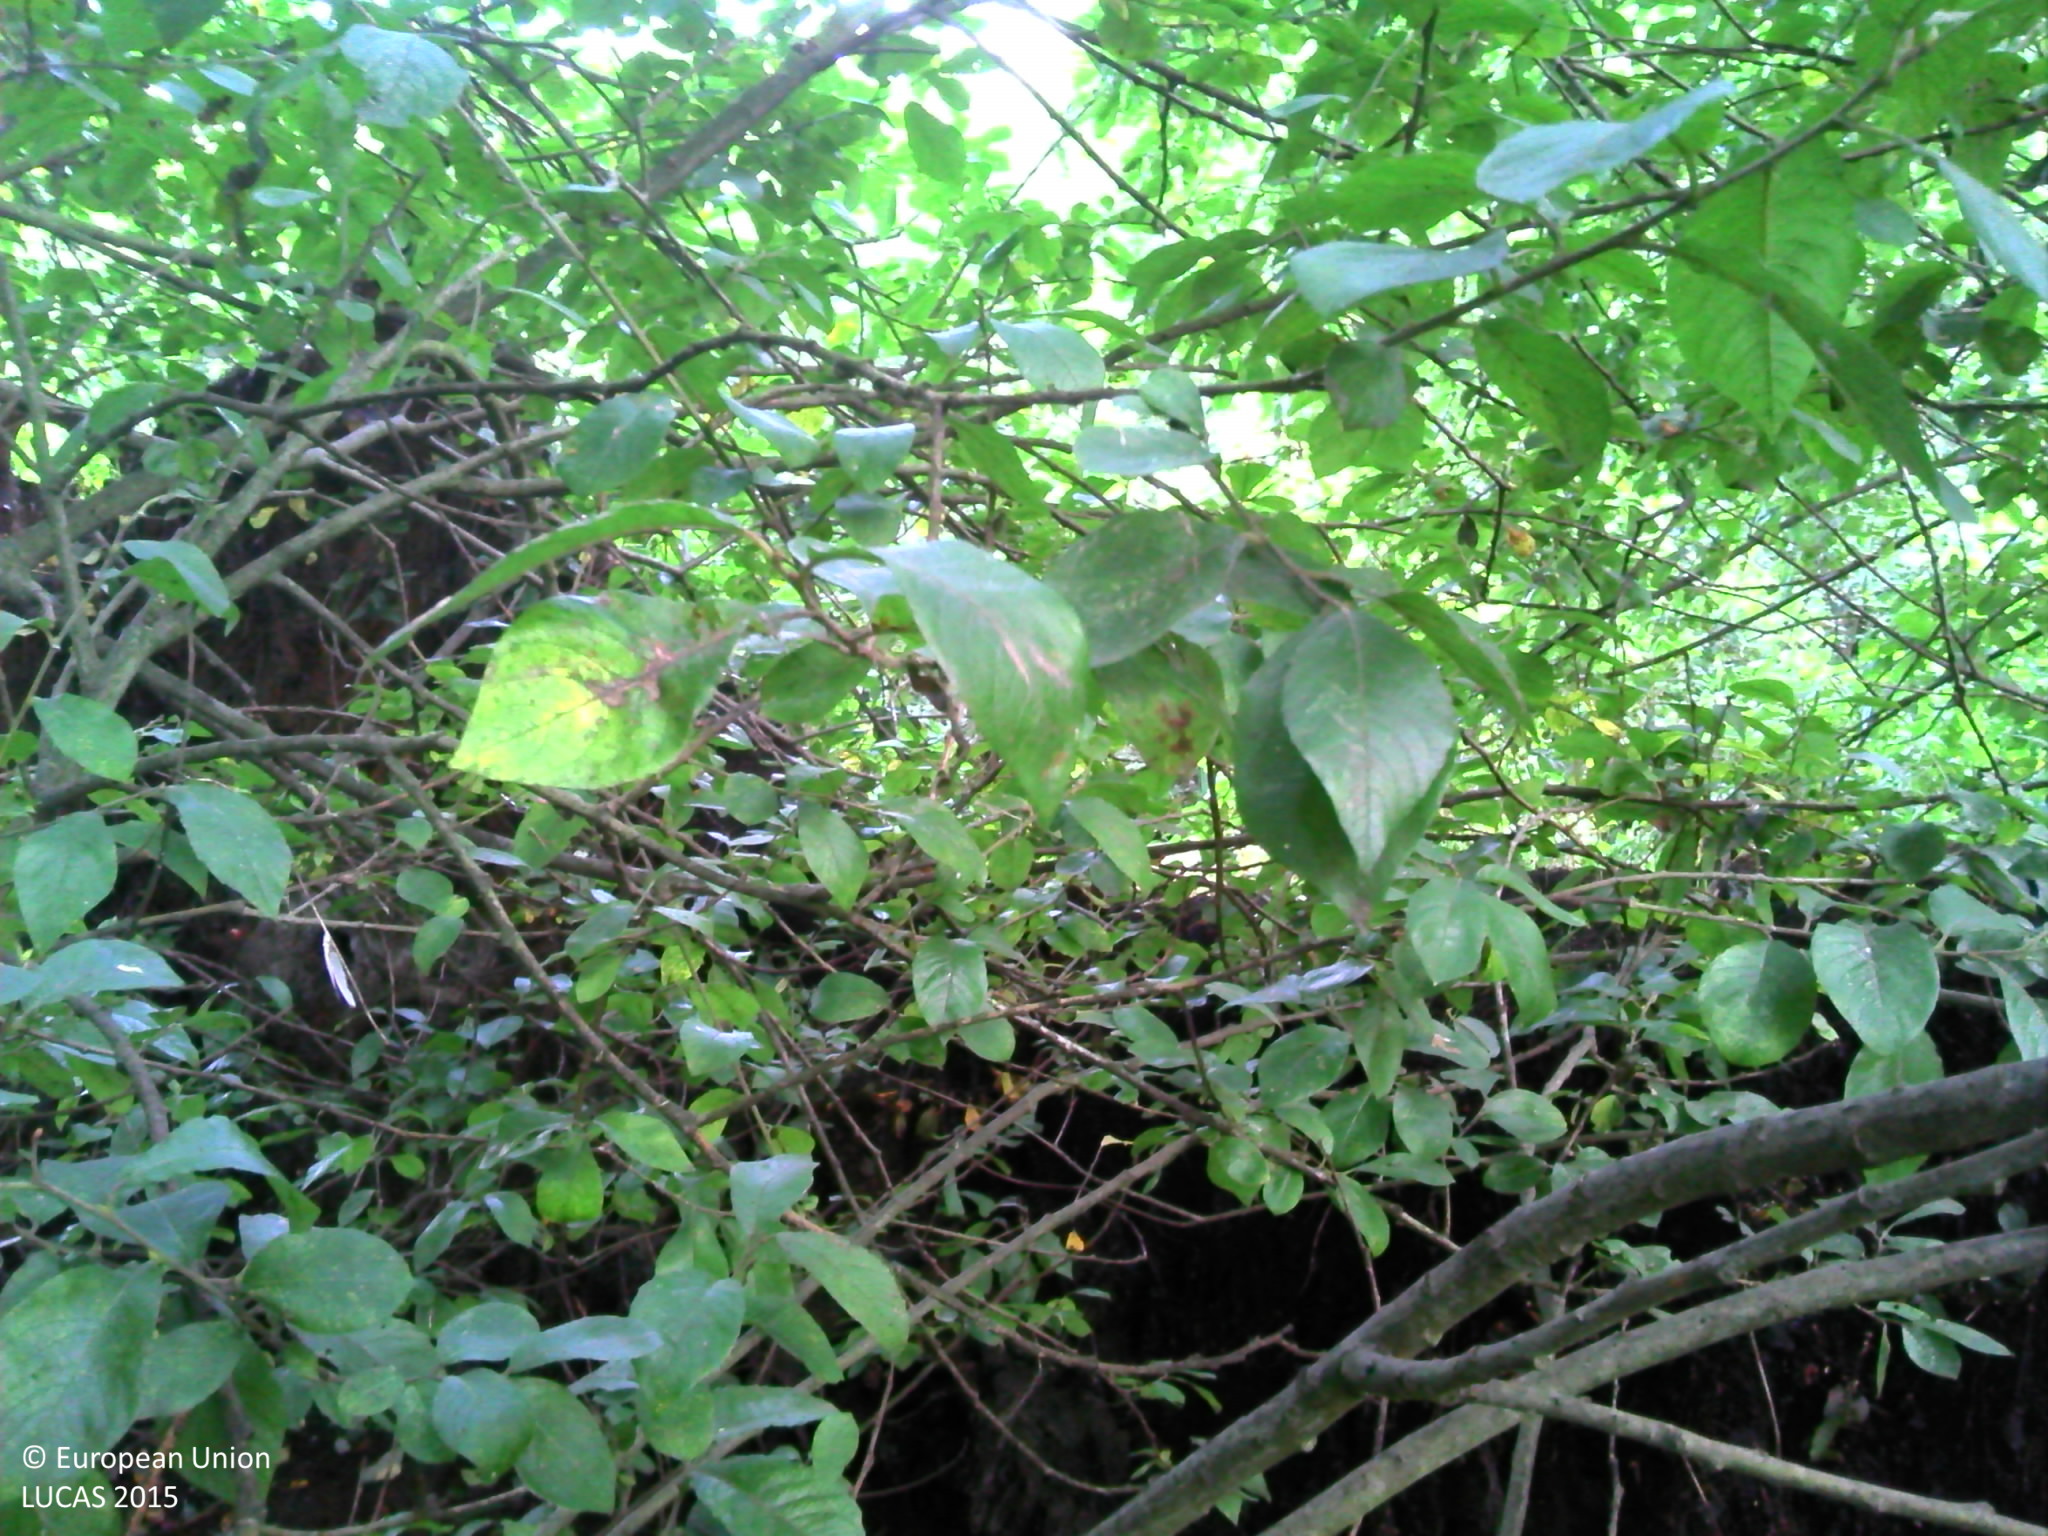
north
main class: Woodland
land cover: Broadleaved woodland
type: floodplain forest
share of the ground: > 75 %
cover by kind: broadleaved forest trees 70 %, herbaceous plants 20 %, shrubs 10 %
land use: Forestry
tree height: > 5 m
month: September
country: BE
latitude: 51.0720
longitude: 4.3579
